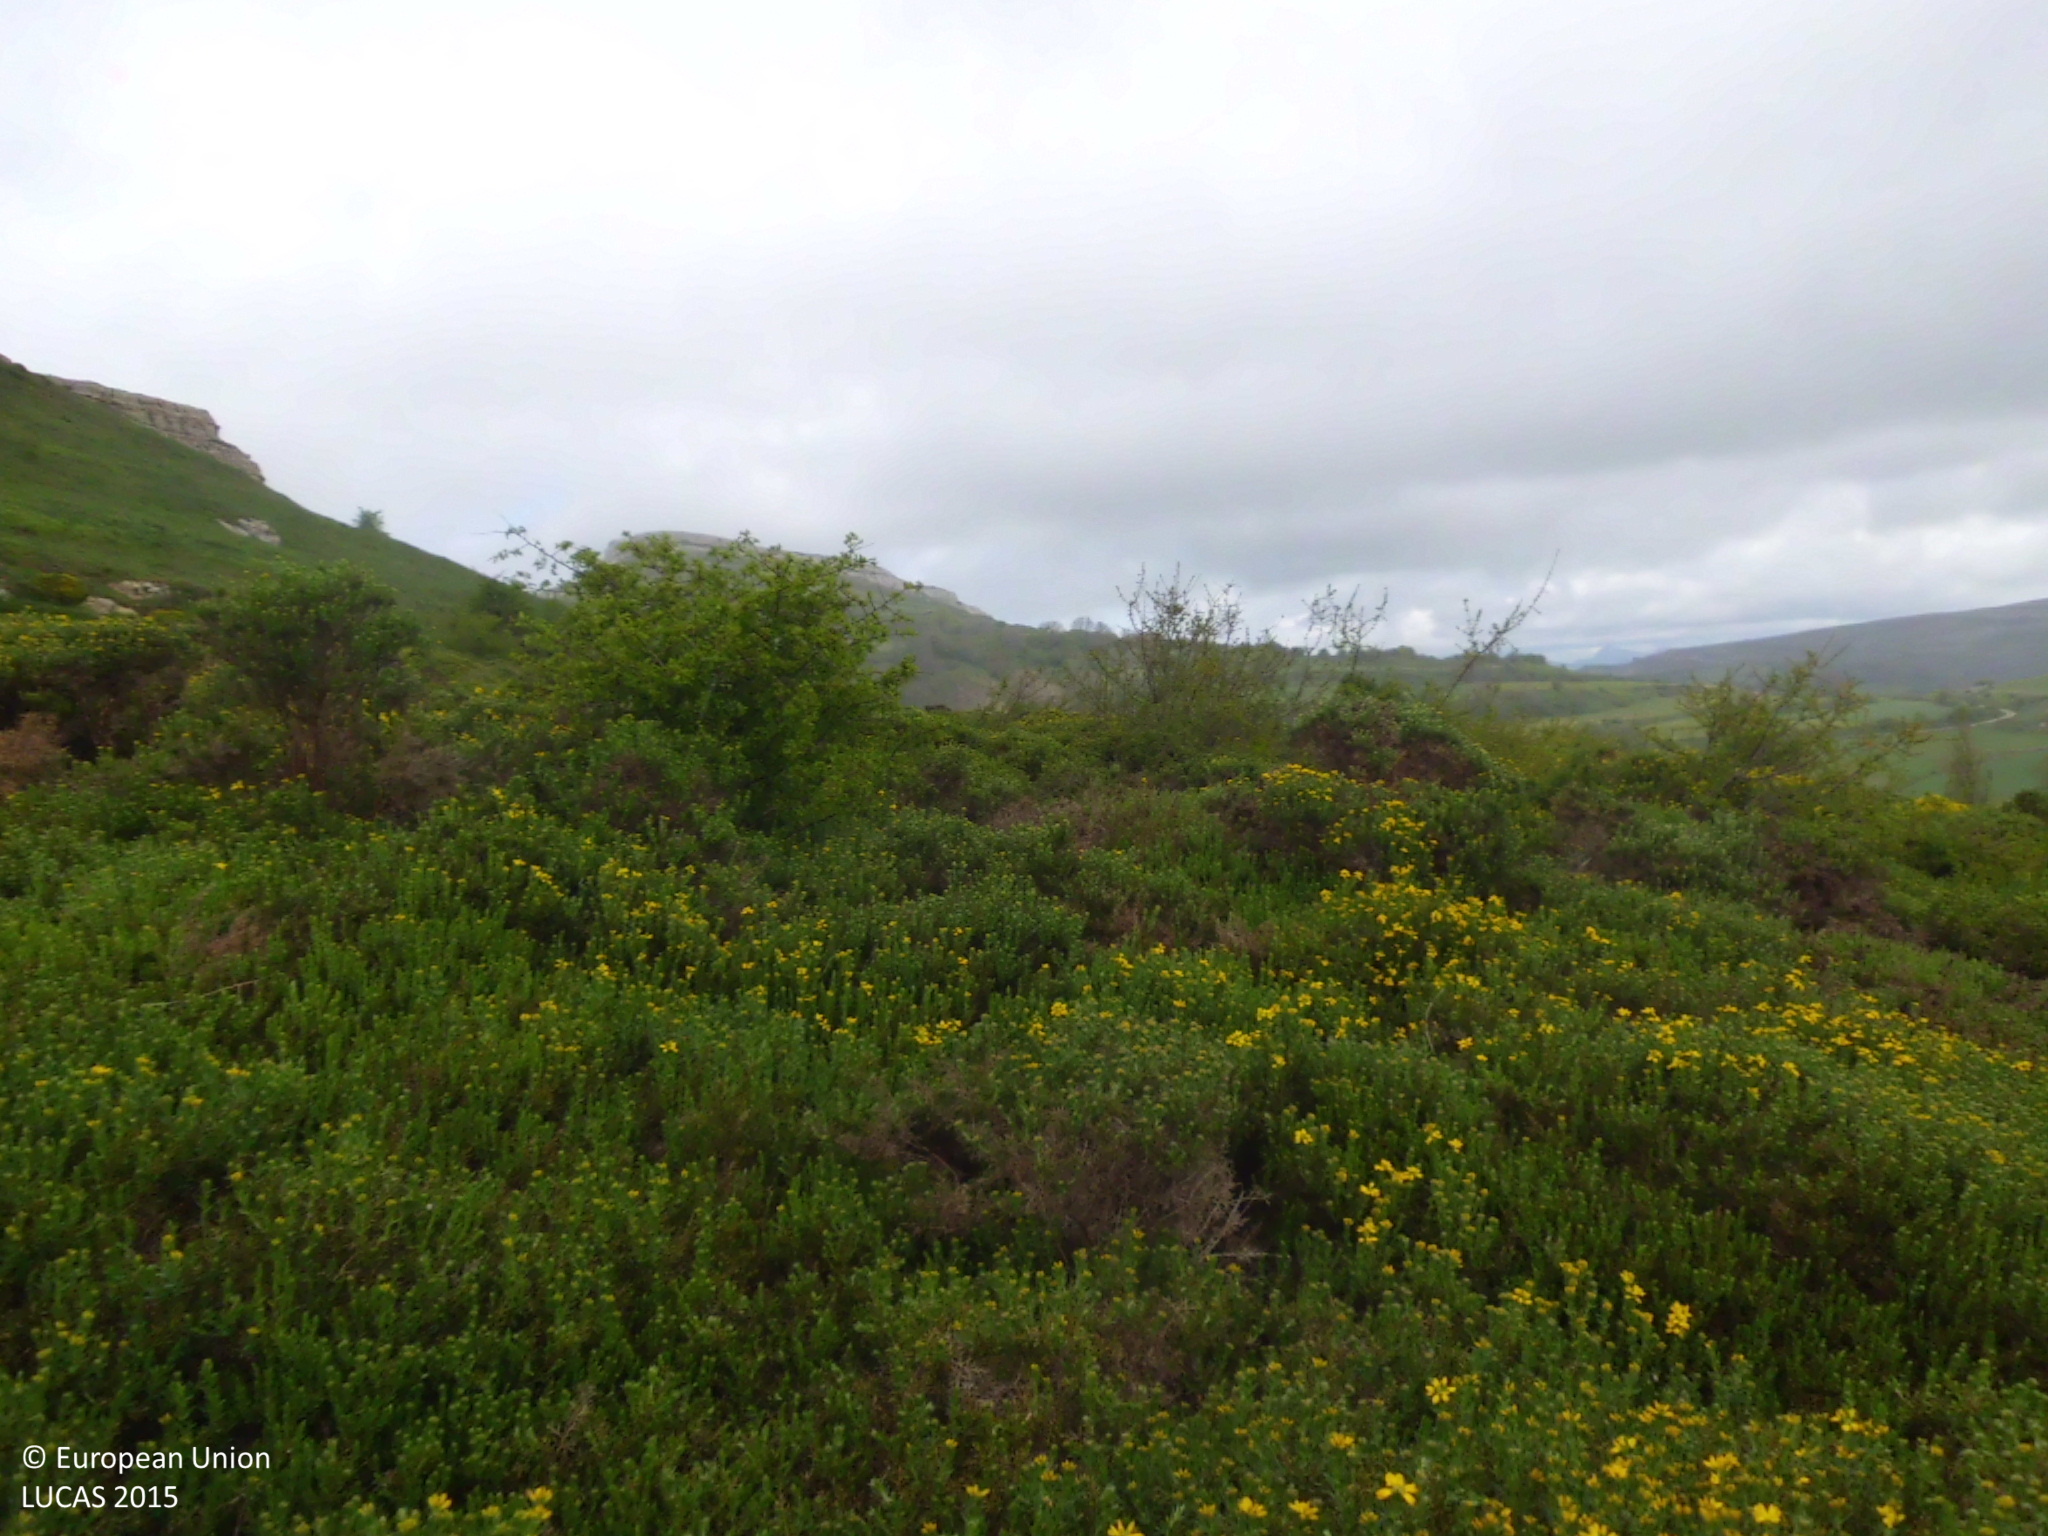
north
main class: Shrubland
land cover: Shrubland without tree cover
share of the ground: > 75 %
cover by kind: shrubs 80 %, herbaceous plants 20 %
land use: Semi-natural and natural areas not in use
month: May
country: ES
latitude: 42.9050
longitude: -3.8477
